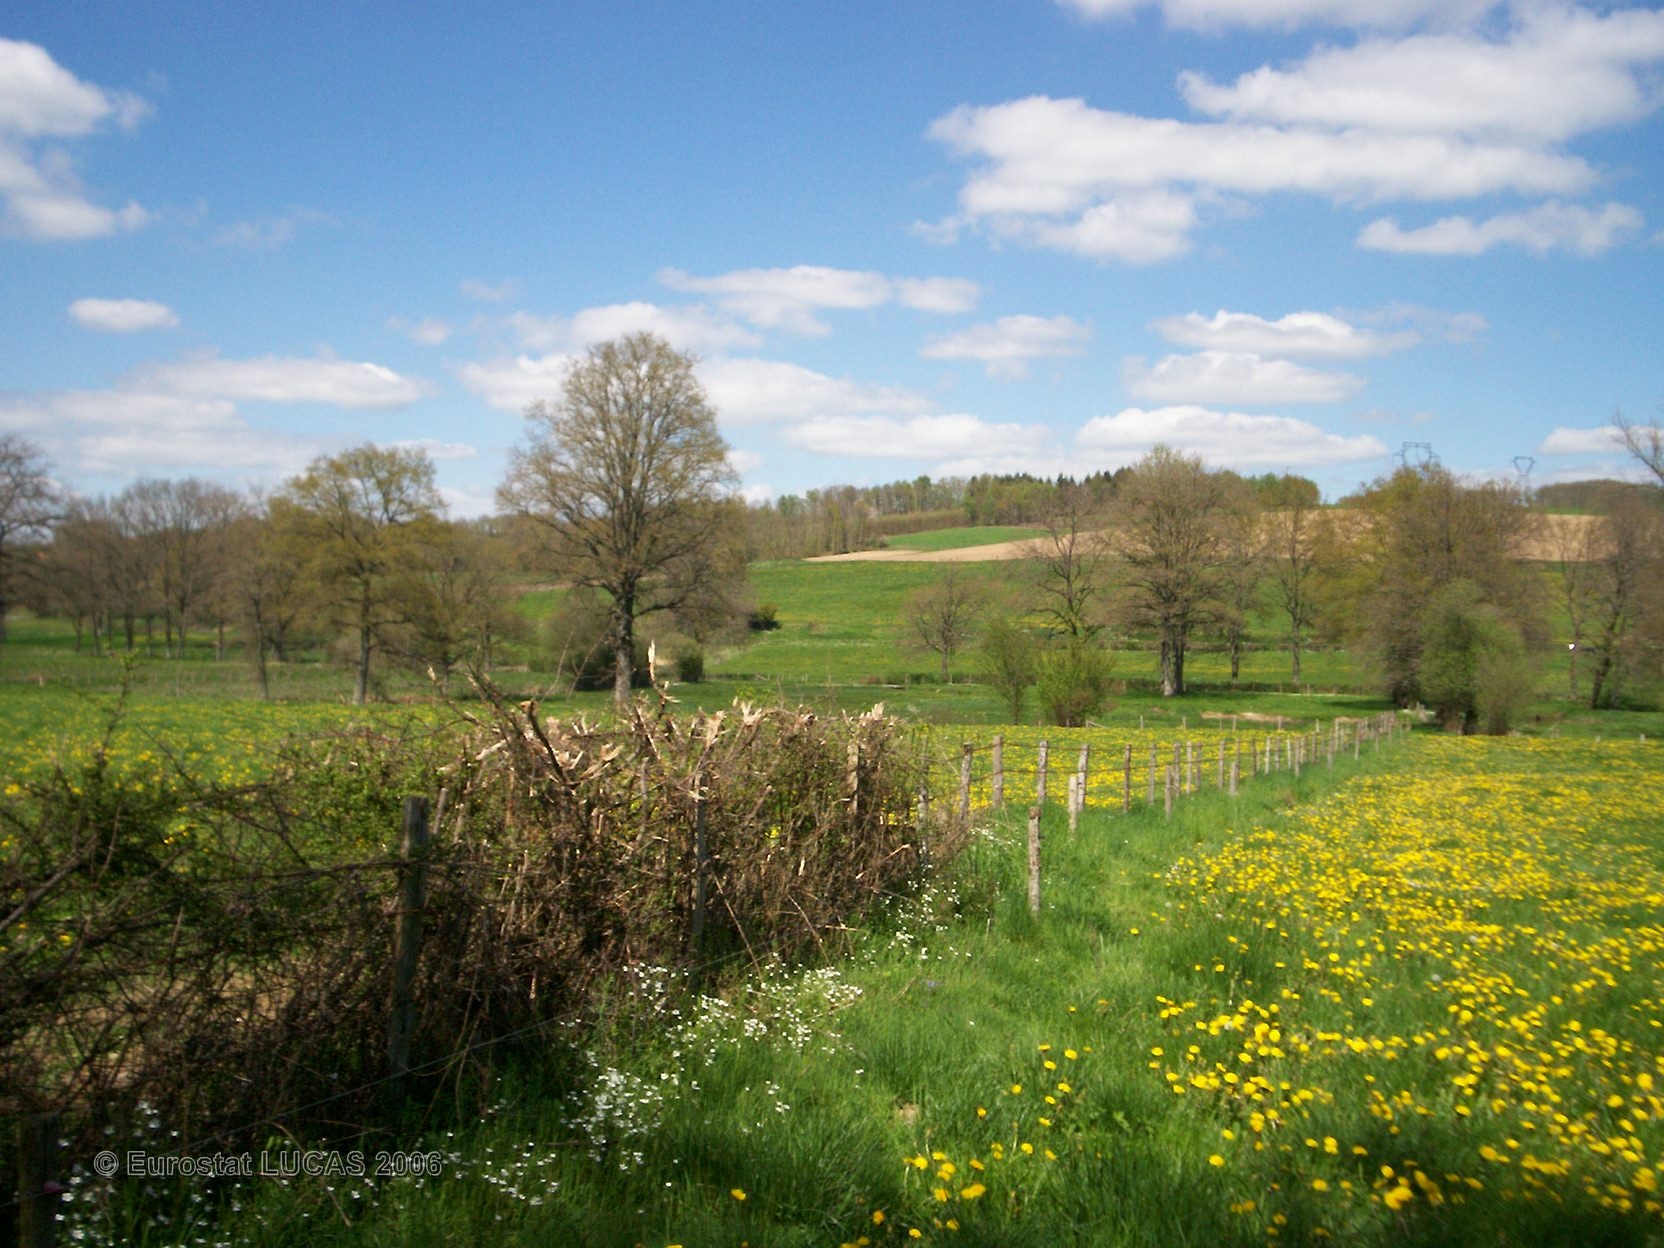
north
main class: Grassland
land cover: Grassland with sparse tree/shrub cover
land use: Agriculture (excluding fallow land and kitchen gardens)
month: April
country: FR
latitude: 46.2596
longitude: 1.6497
